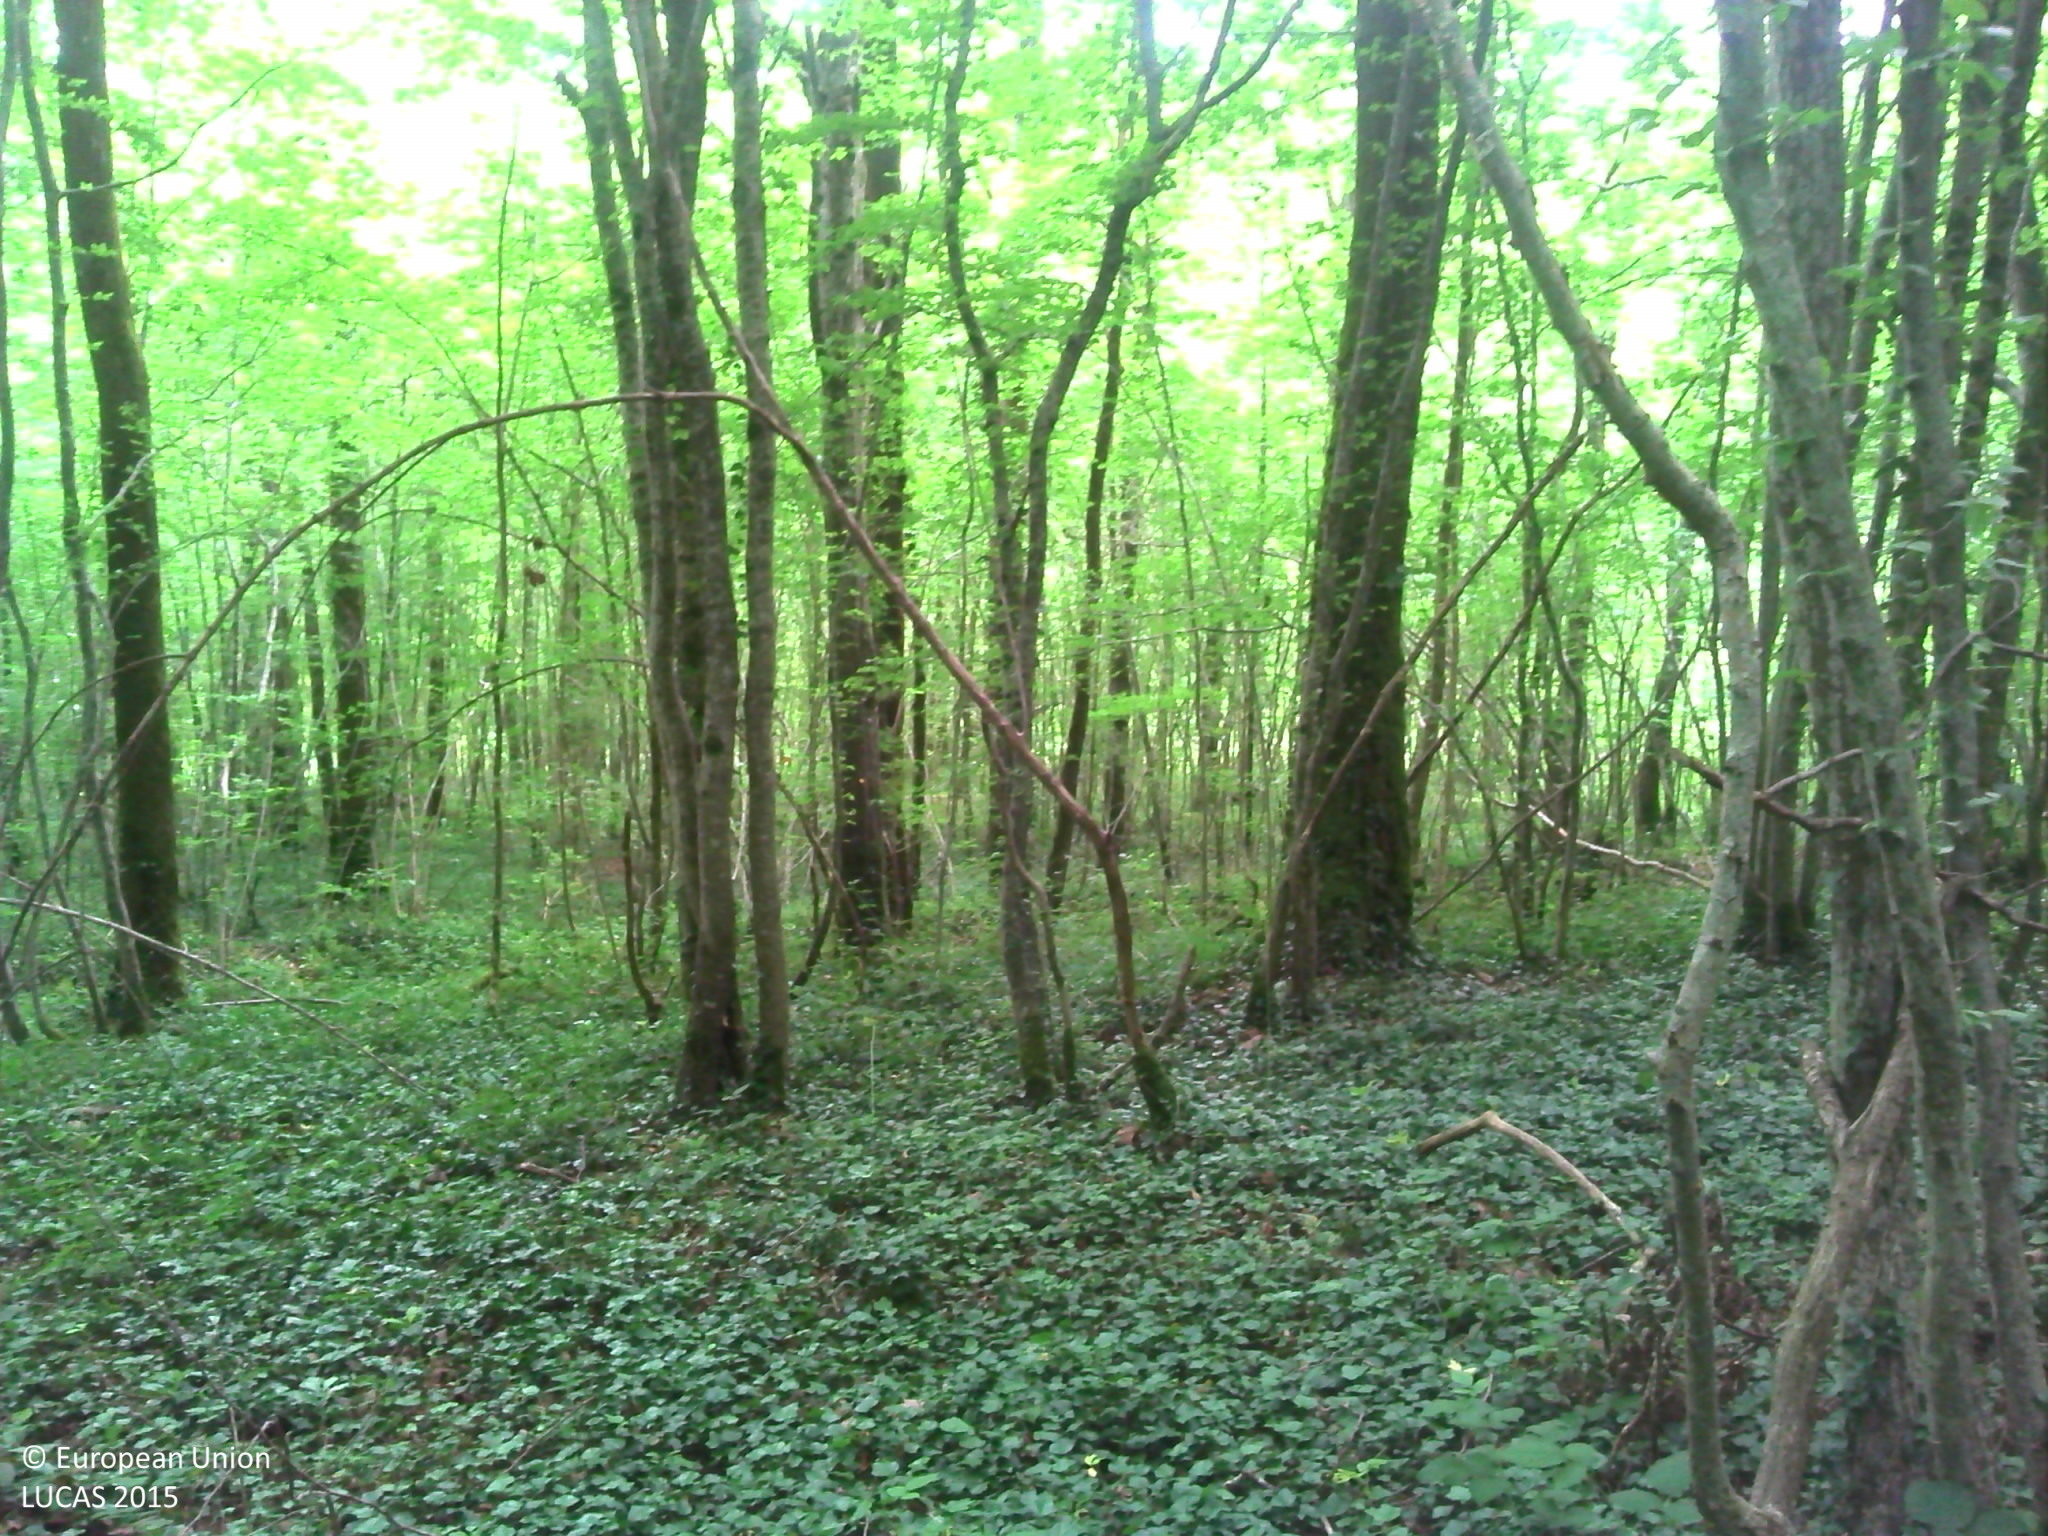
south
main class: Woodland
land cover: Broadleaved woodland
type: beech forest
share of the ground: > 75 %
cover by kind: broadleaved forest trees 90 %, herbaceous plants 10 %
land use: Forestry
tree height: > 5 m
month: June
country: FR
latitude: 48.3274
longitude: 5.0216
